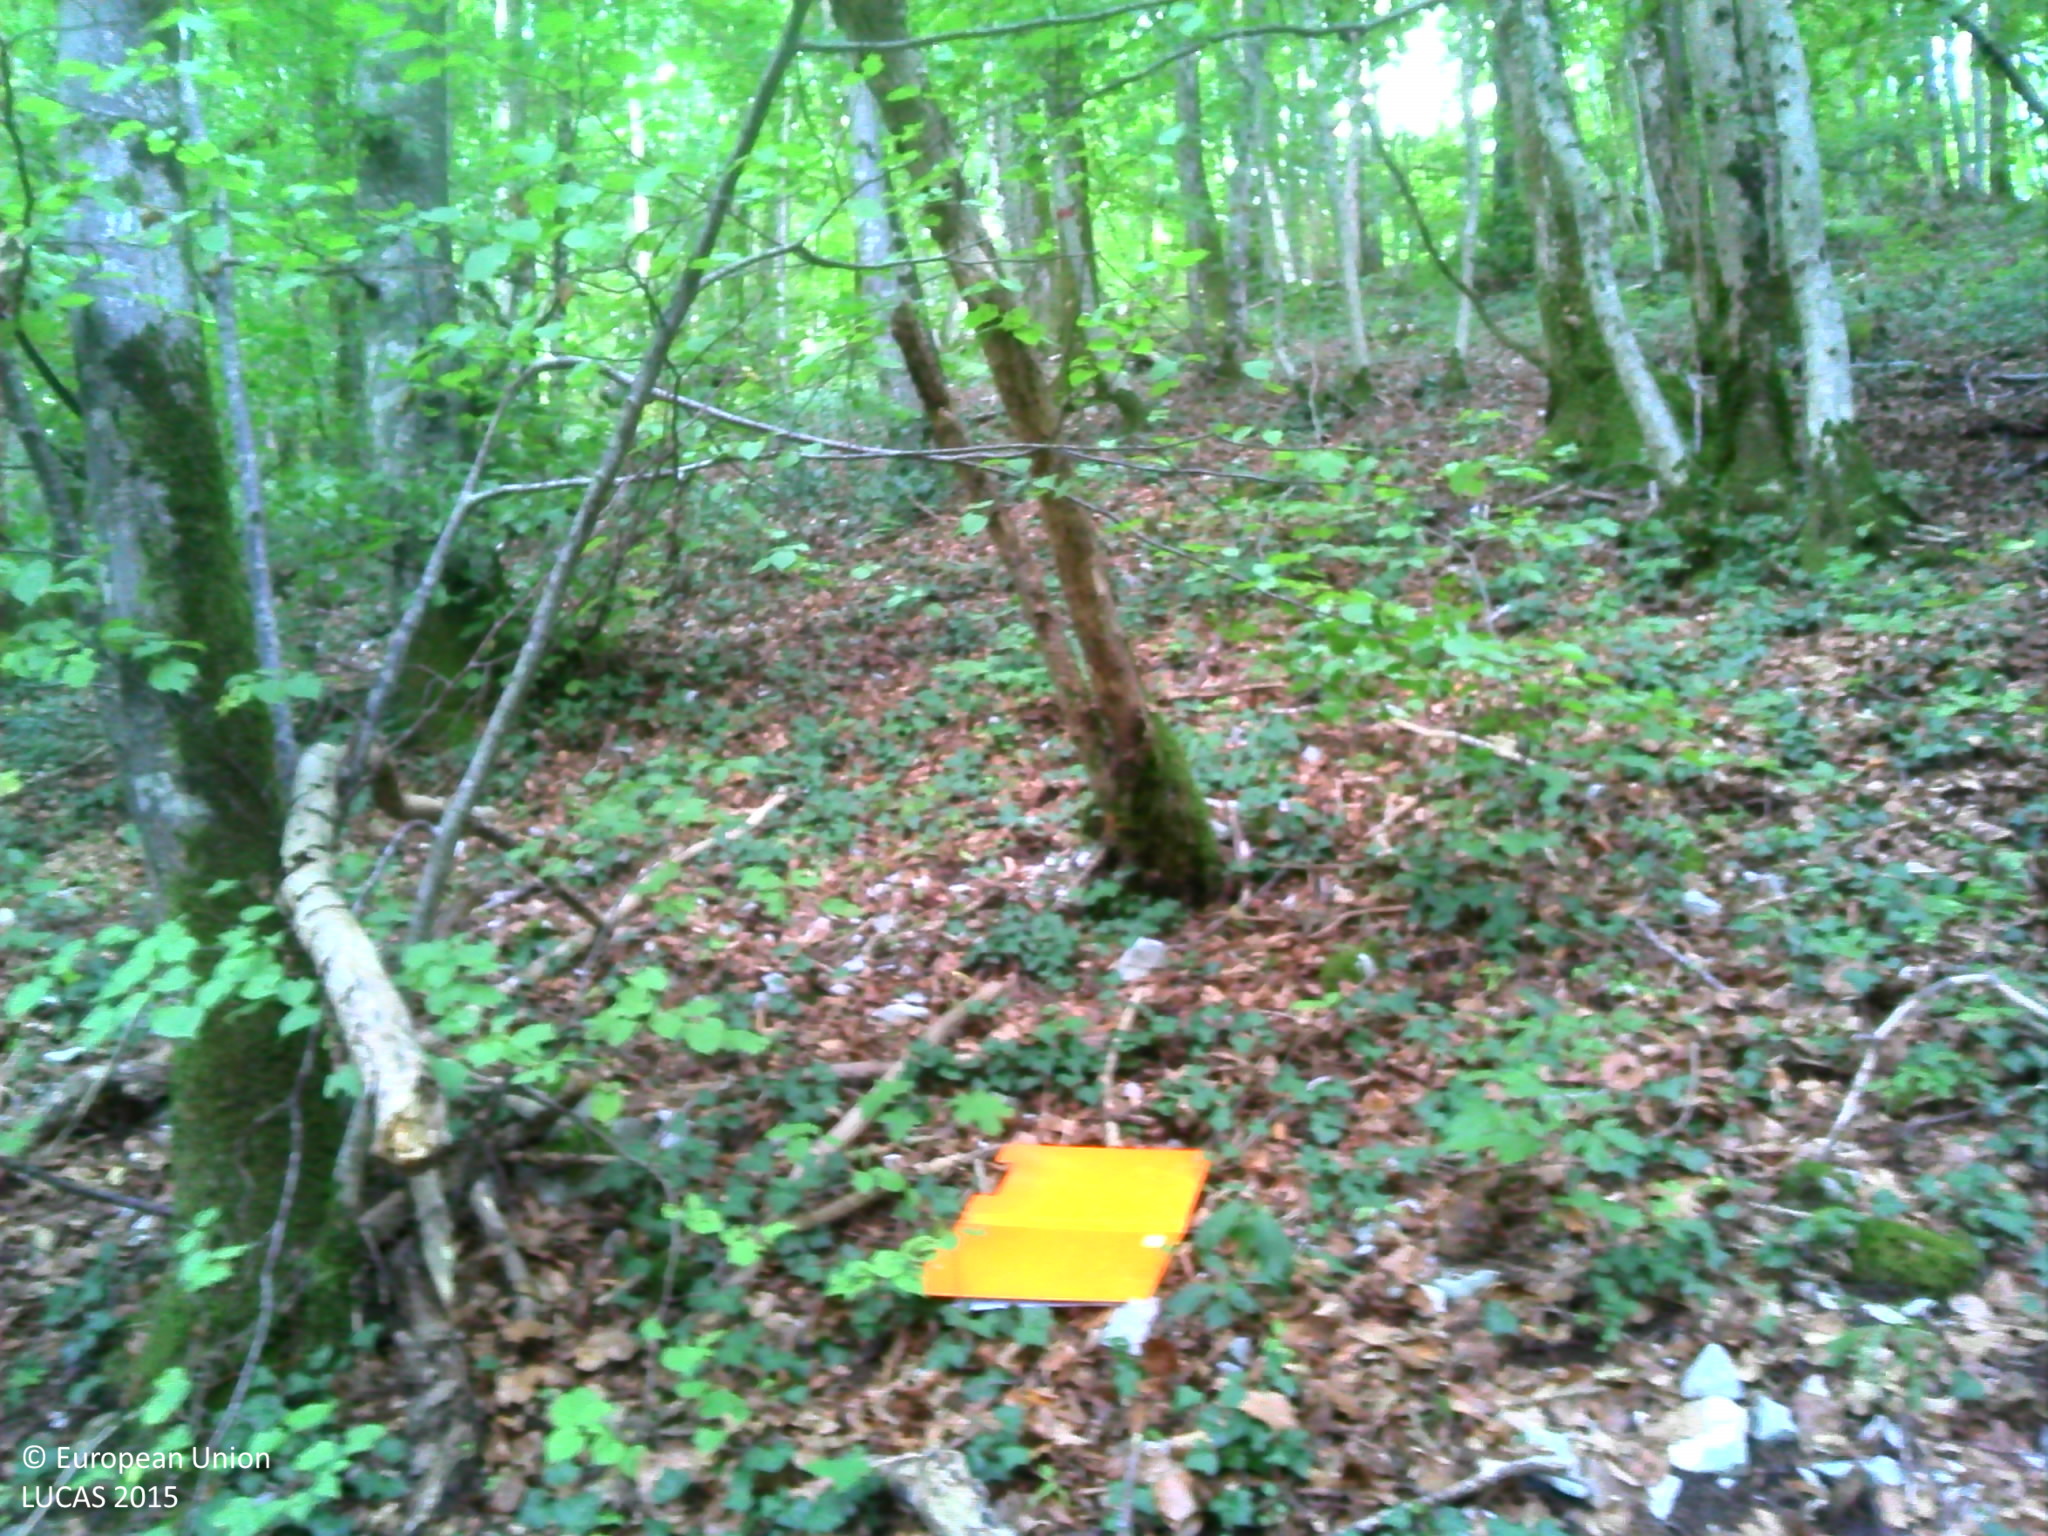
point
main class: Woodland
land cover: Broadleaved woodland
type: beech forest
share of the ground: > 75 %
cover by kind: broadleaved forest trees 100 %
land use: Forestry
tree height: > 5 m
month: September
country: FR
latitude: 47.4615
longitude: 6.3801
